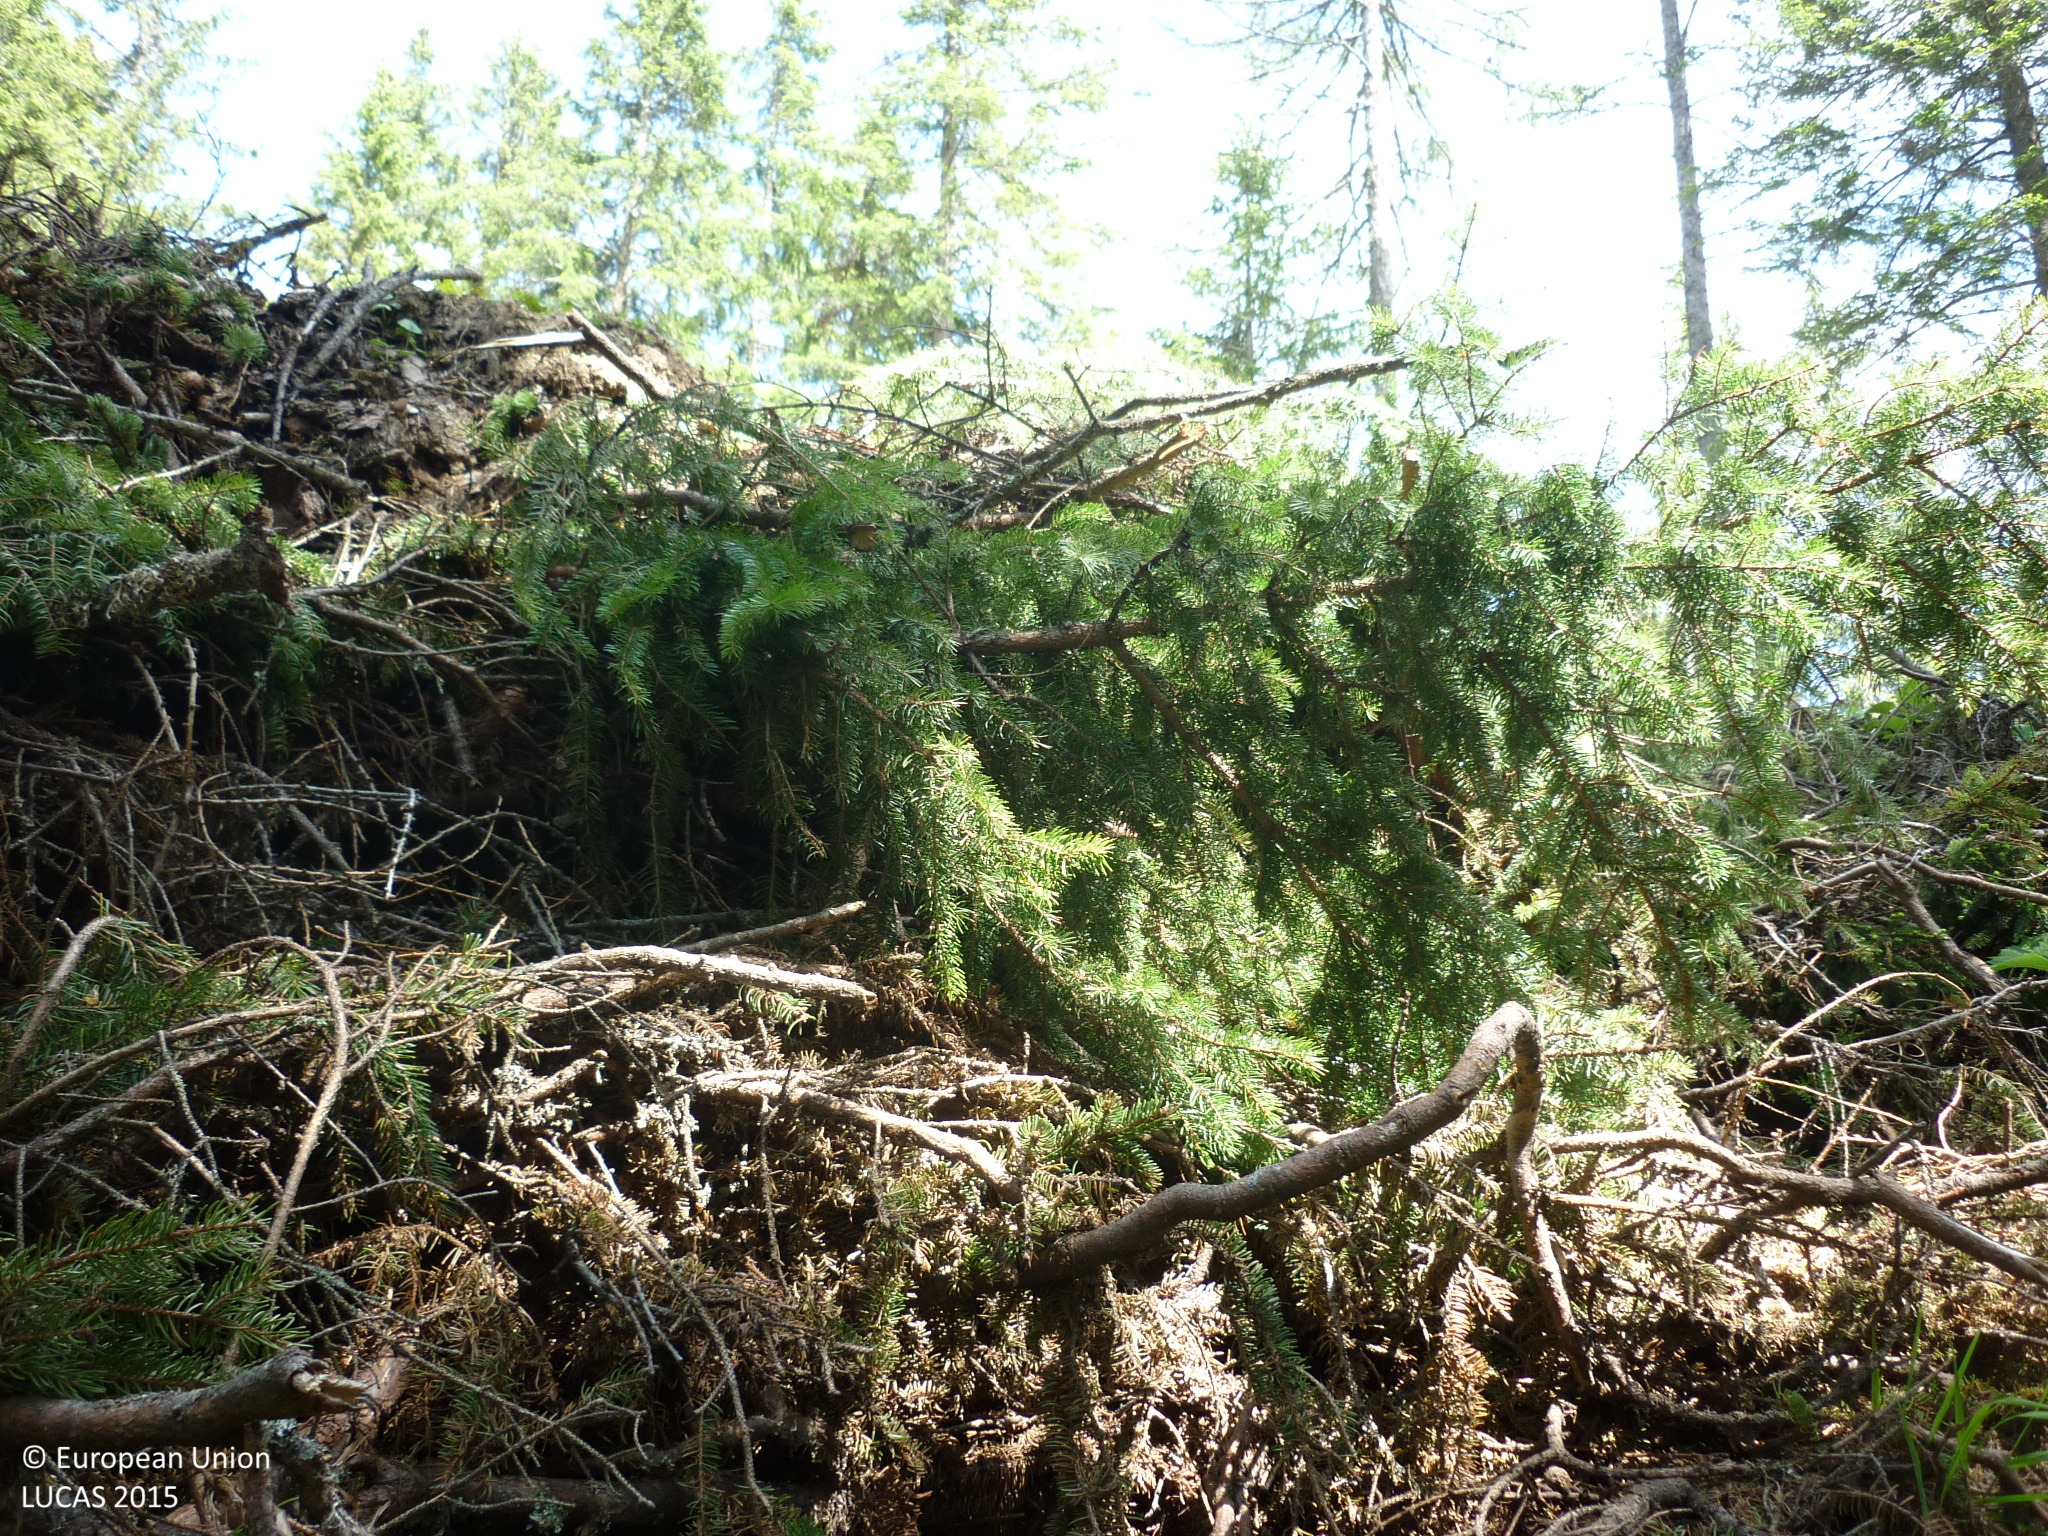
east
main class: Woodland
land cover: Spruce dominated coniferous woodland
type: alpine coniferous forest
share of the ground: > 75 %
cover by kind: coniferous forest trees 80 %, herbaceous plants 15 %, unconsolidated bare surface 5 %
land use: Forestry
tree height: > 5 m
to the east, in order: Spruce dominated coniferous woodland; Tracks; Spontaneously vegetated surfaces; Fences; Spruce dominated coniferous woodland
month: June
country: AT
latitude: 47.2537
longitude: 14.3723
